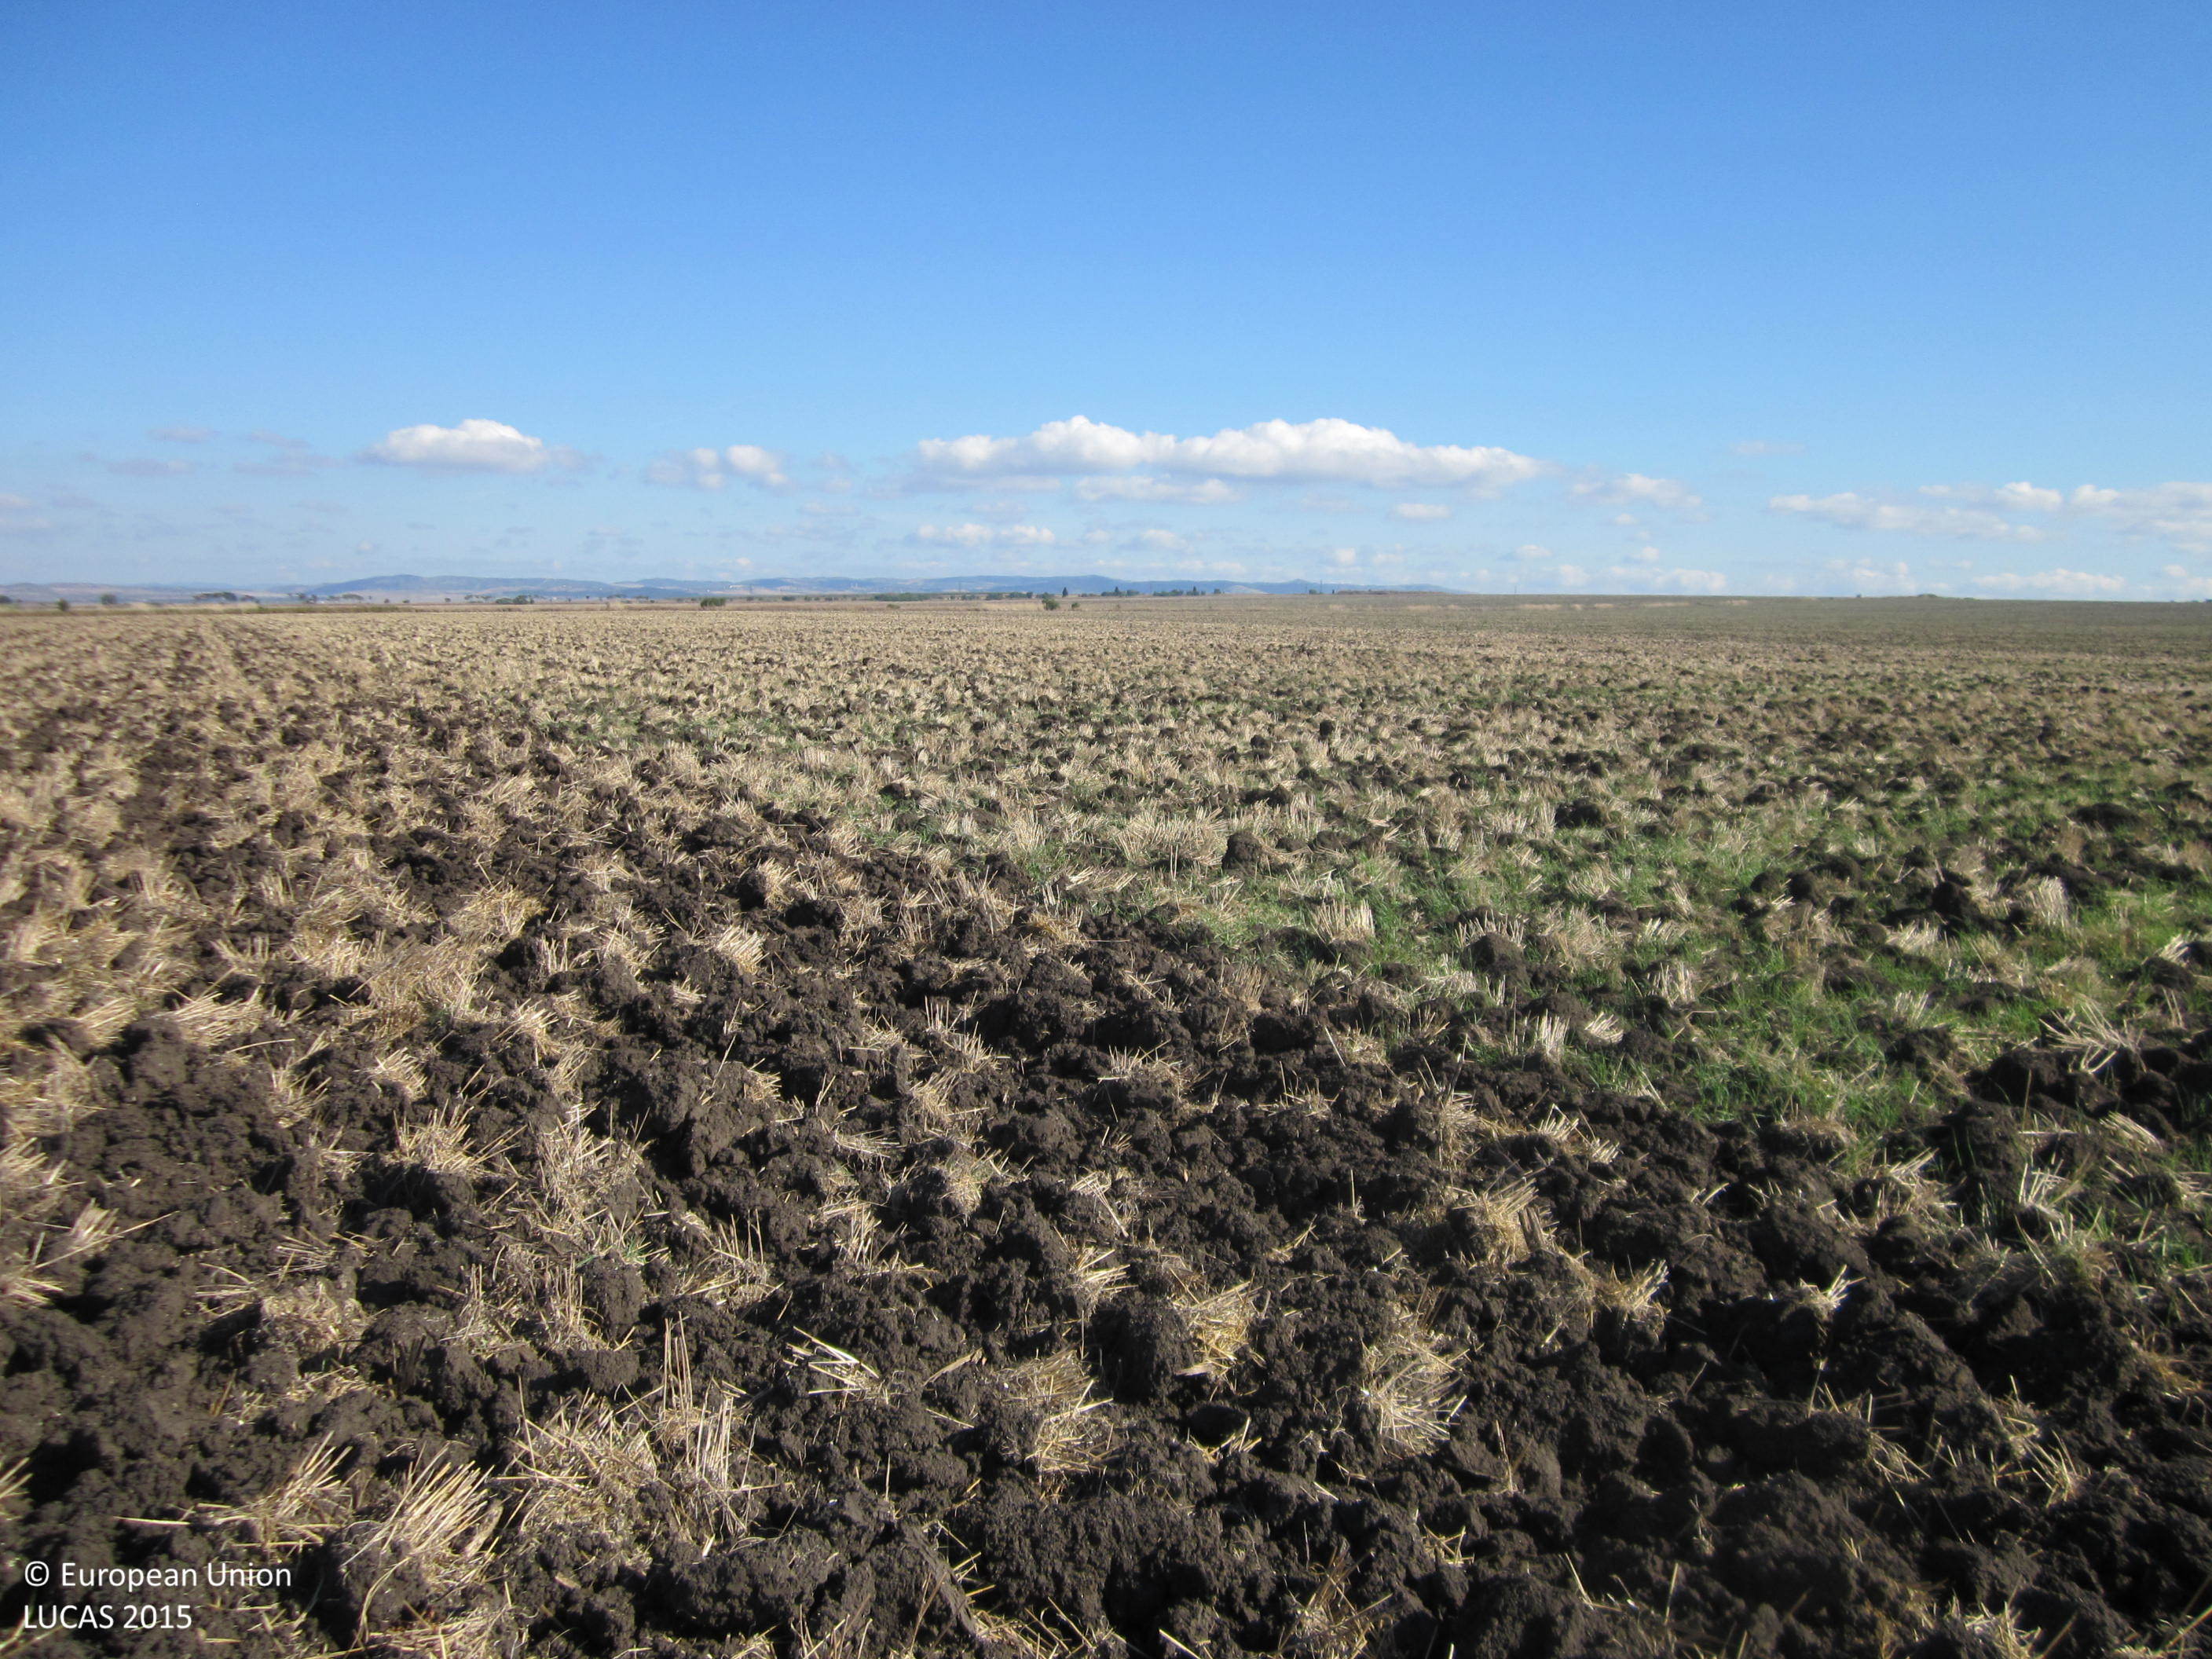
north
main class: Cropland
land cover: Common wheat
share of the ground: < 10 %
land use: Agriculture (excluding fallow land and kitchen gardens)
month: September
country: BG
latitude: 42.5404
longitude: 27.3687
